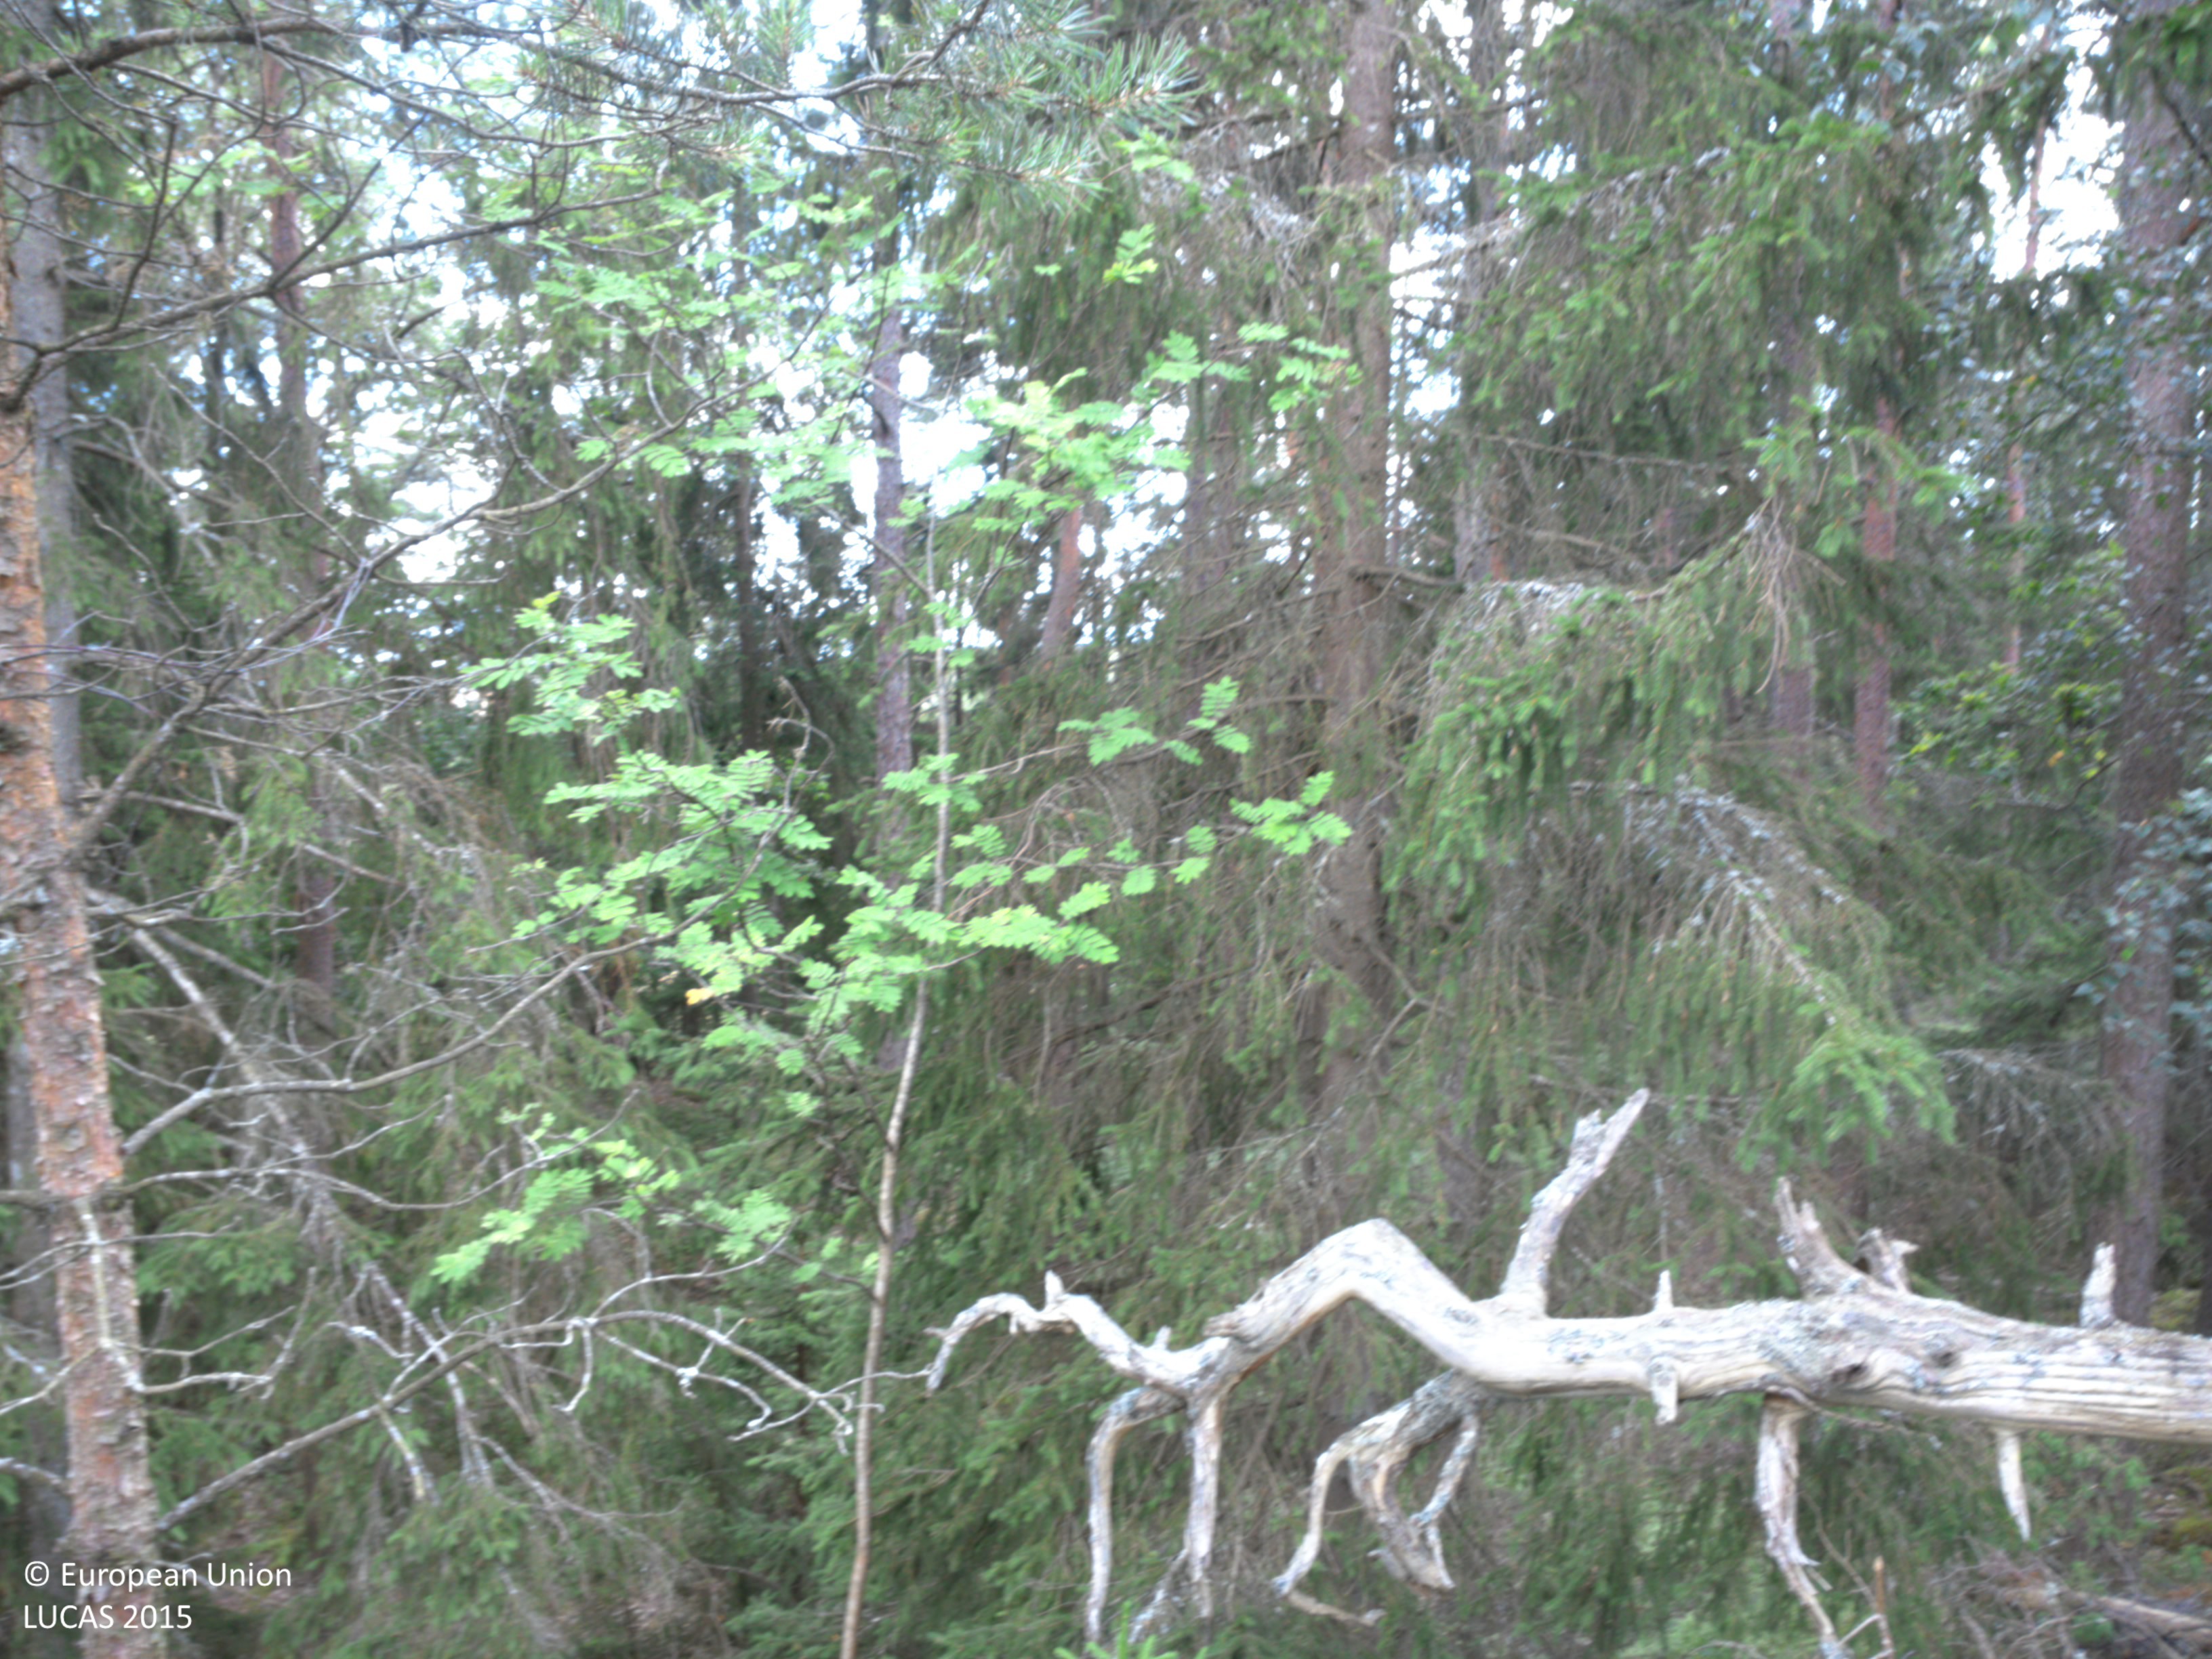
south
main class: Woodland
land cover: Pine dominated coniferous woodland
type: boreal forest
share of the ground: 50 - 75 %
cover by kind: coniferous forest trees 50 %, lichens and mosses 25 %, consolidated bare surface 15 %, herbaceous plants 10 %
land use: Forestry
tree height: > 5 m
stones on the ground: < 10 %
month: July
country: SE
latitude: 58.2090
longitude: 11.6815
